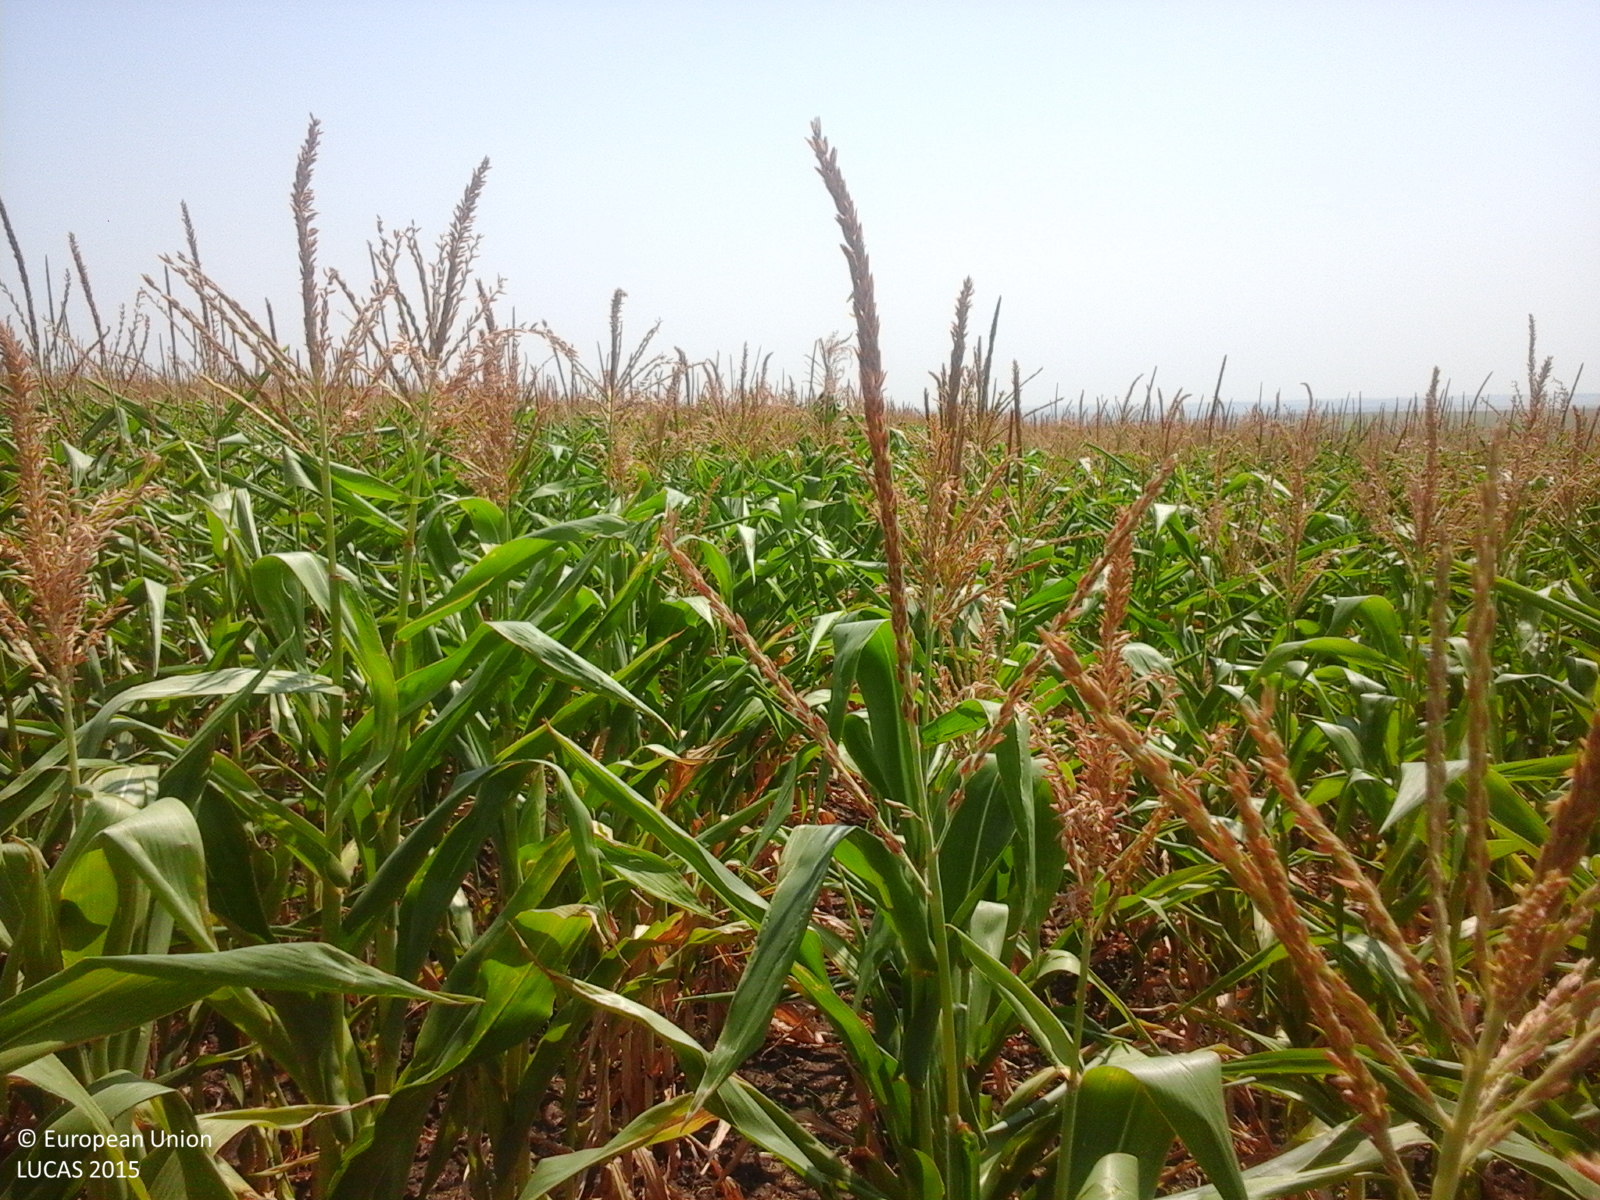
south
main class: Cropland
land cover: Maize
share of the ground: > 75 %
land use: Agriculture (excluding fallow land and kitchen gardens)
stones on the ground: < 10 %
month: July
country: RO
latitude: 45.8961
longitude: 27.9973
